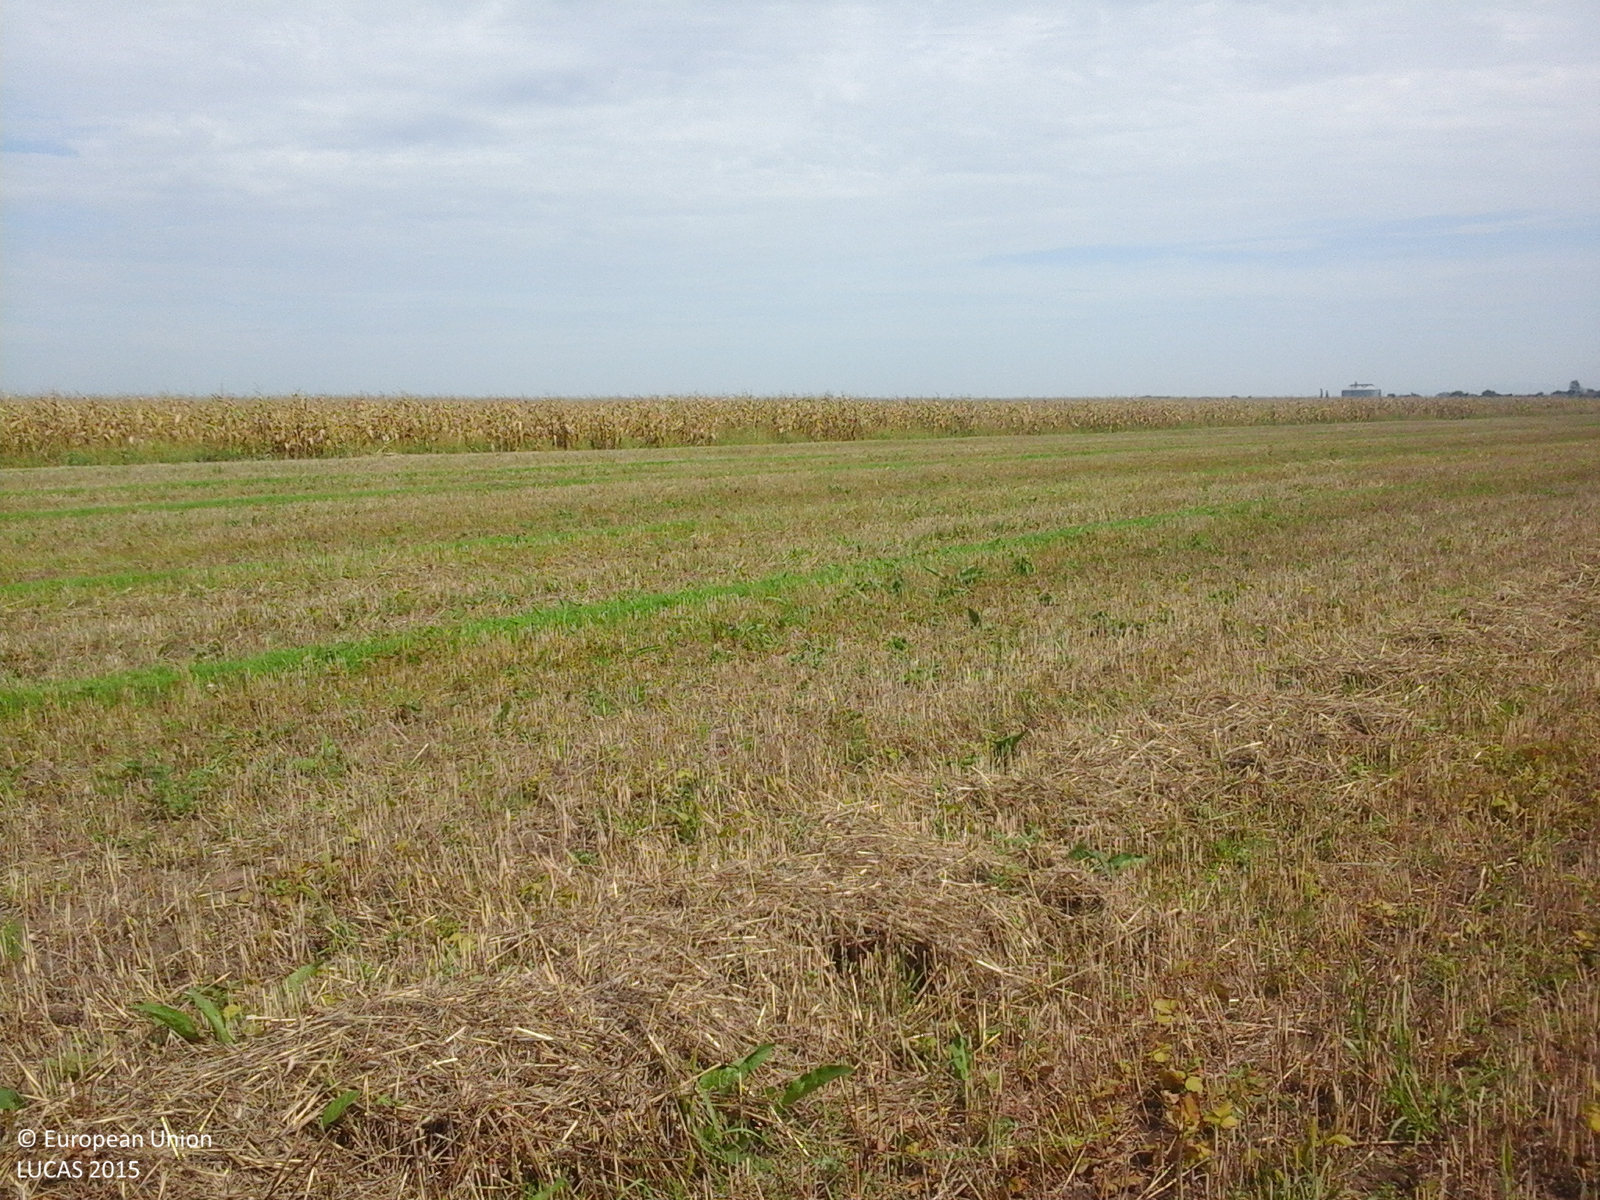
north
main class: Cropland
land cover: Maize
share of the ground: > 75 %
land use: Agriculture (excluding fallow land and kitchen gardens)
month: August
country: RO
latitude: 46.3814
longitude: 21.5182
